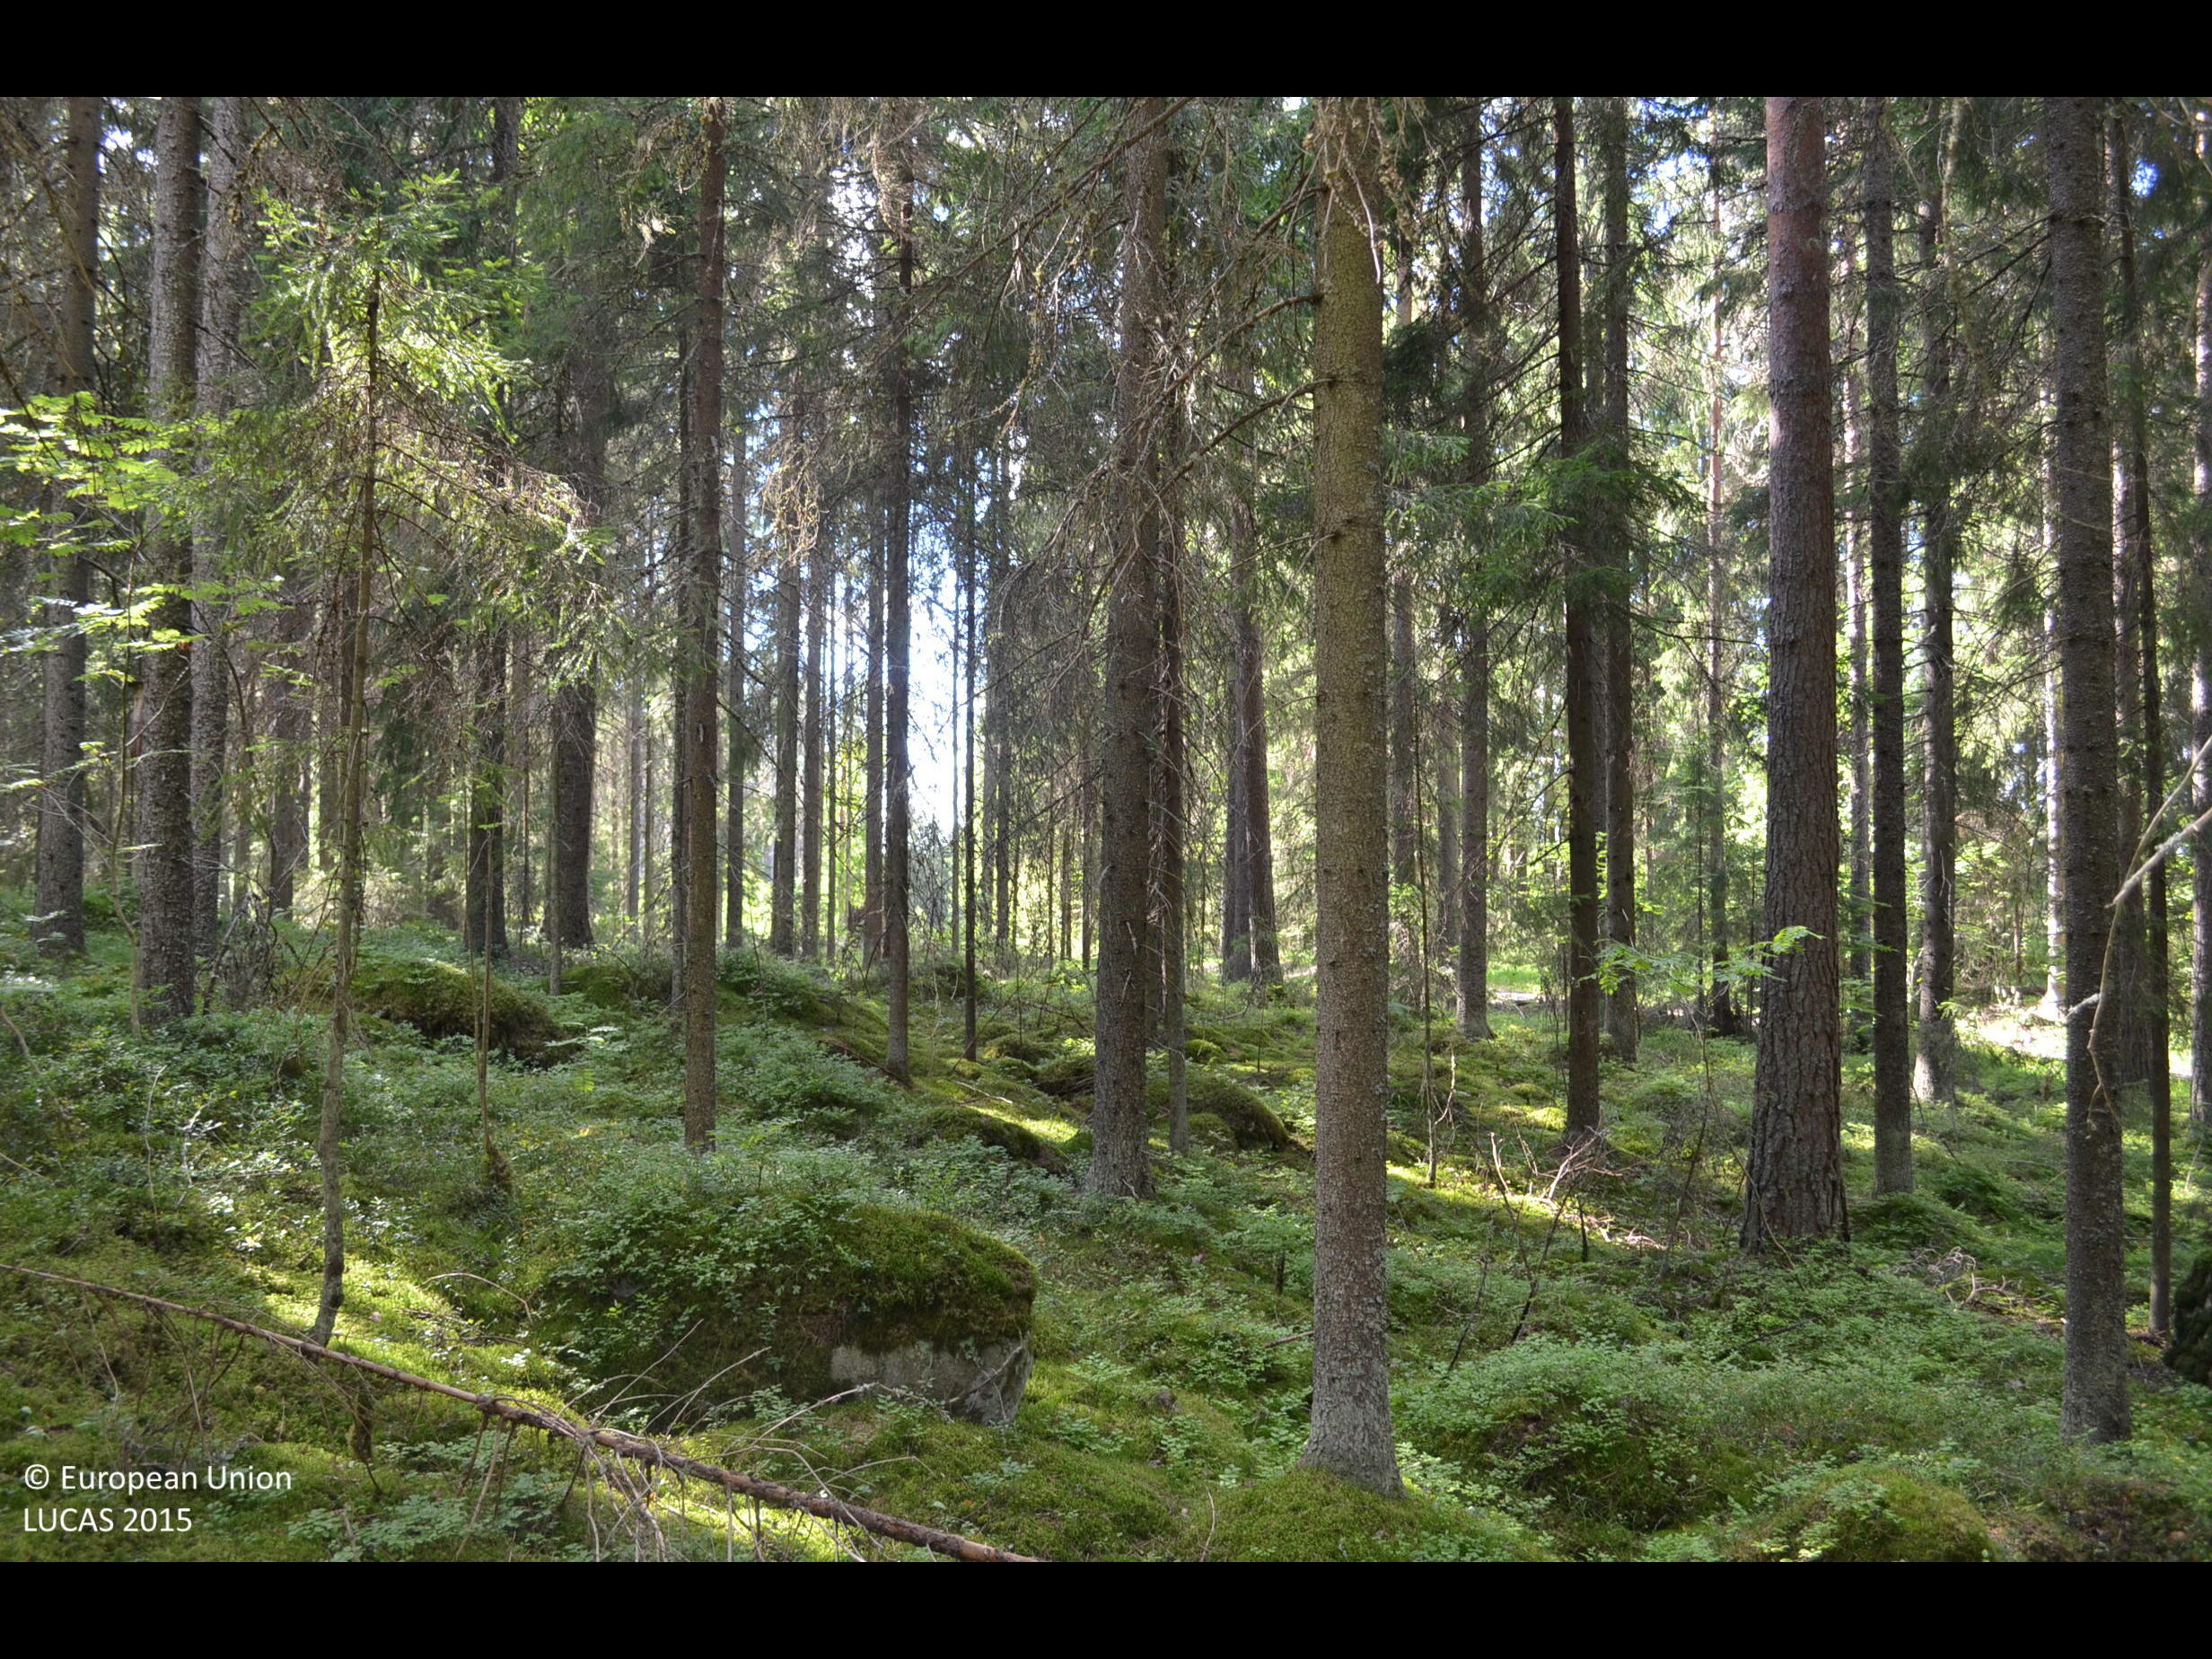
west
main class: Woodland
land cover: Spruce dominated coniferous woodland
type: boreal forest
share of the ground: > 75 %
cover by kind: coniferous forest trees 80 %, shrubs 15 %, broadleaved forest trees 5 %
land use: Forestry
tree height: > 5 m
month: August
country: FI
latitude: 61.6155
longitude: 23.1017
